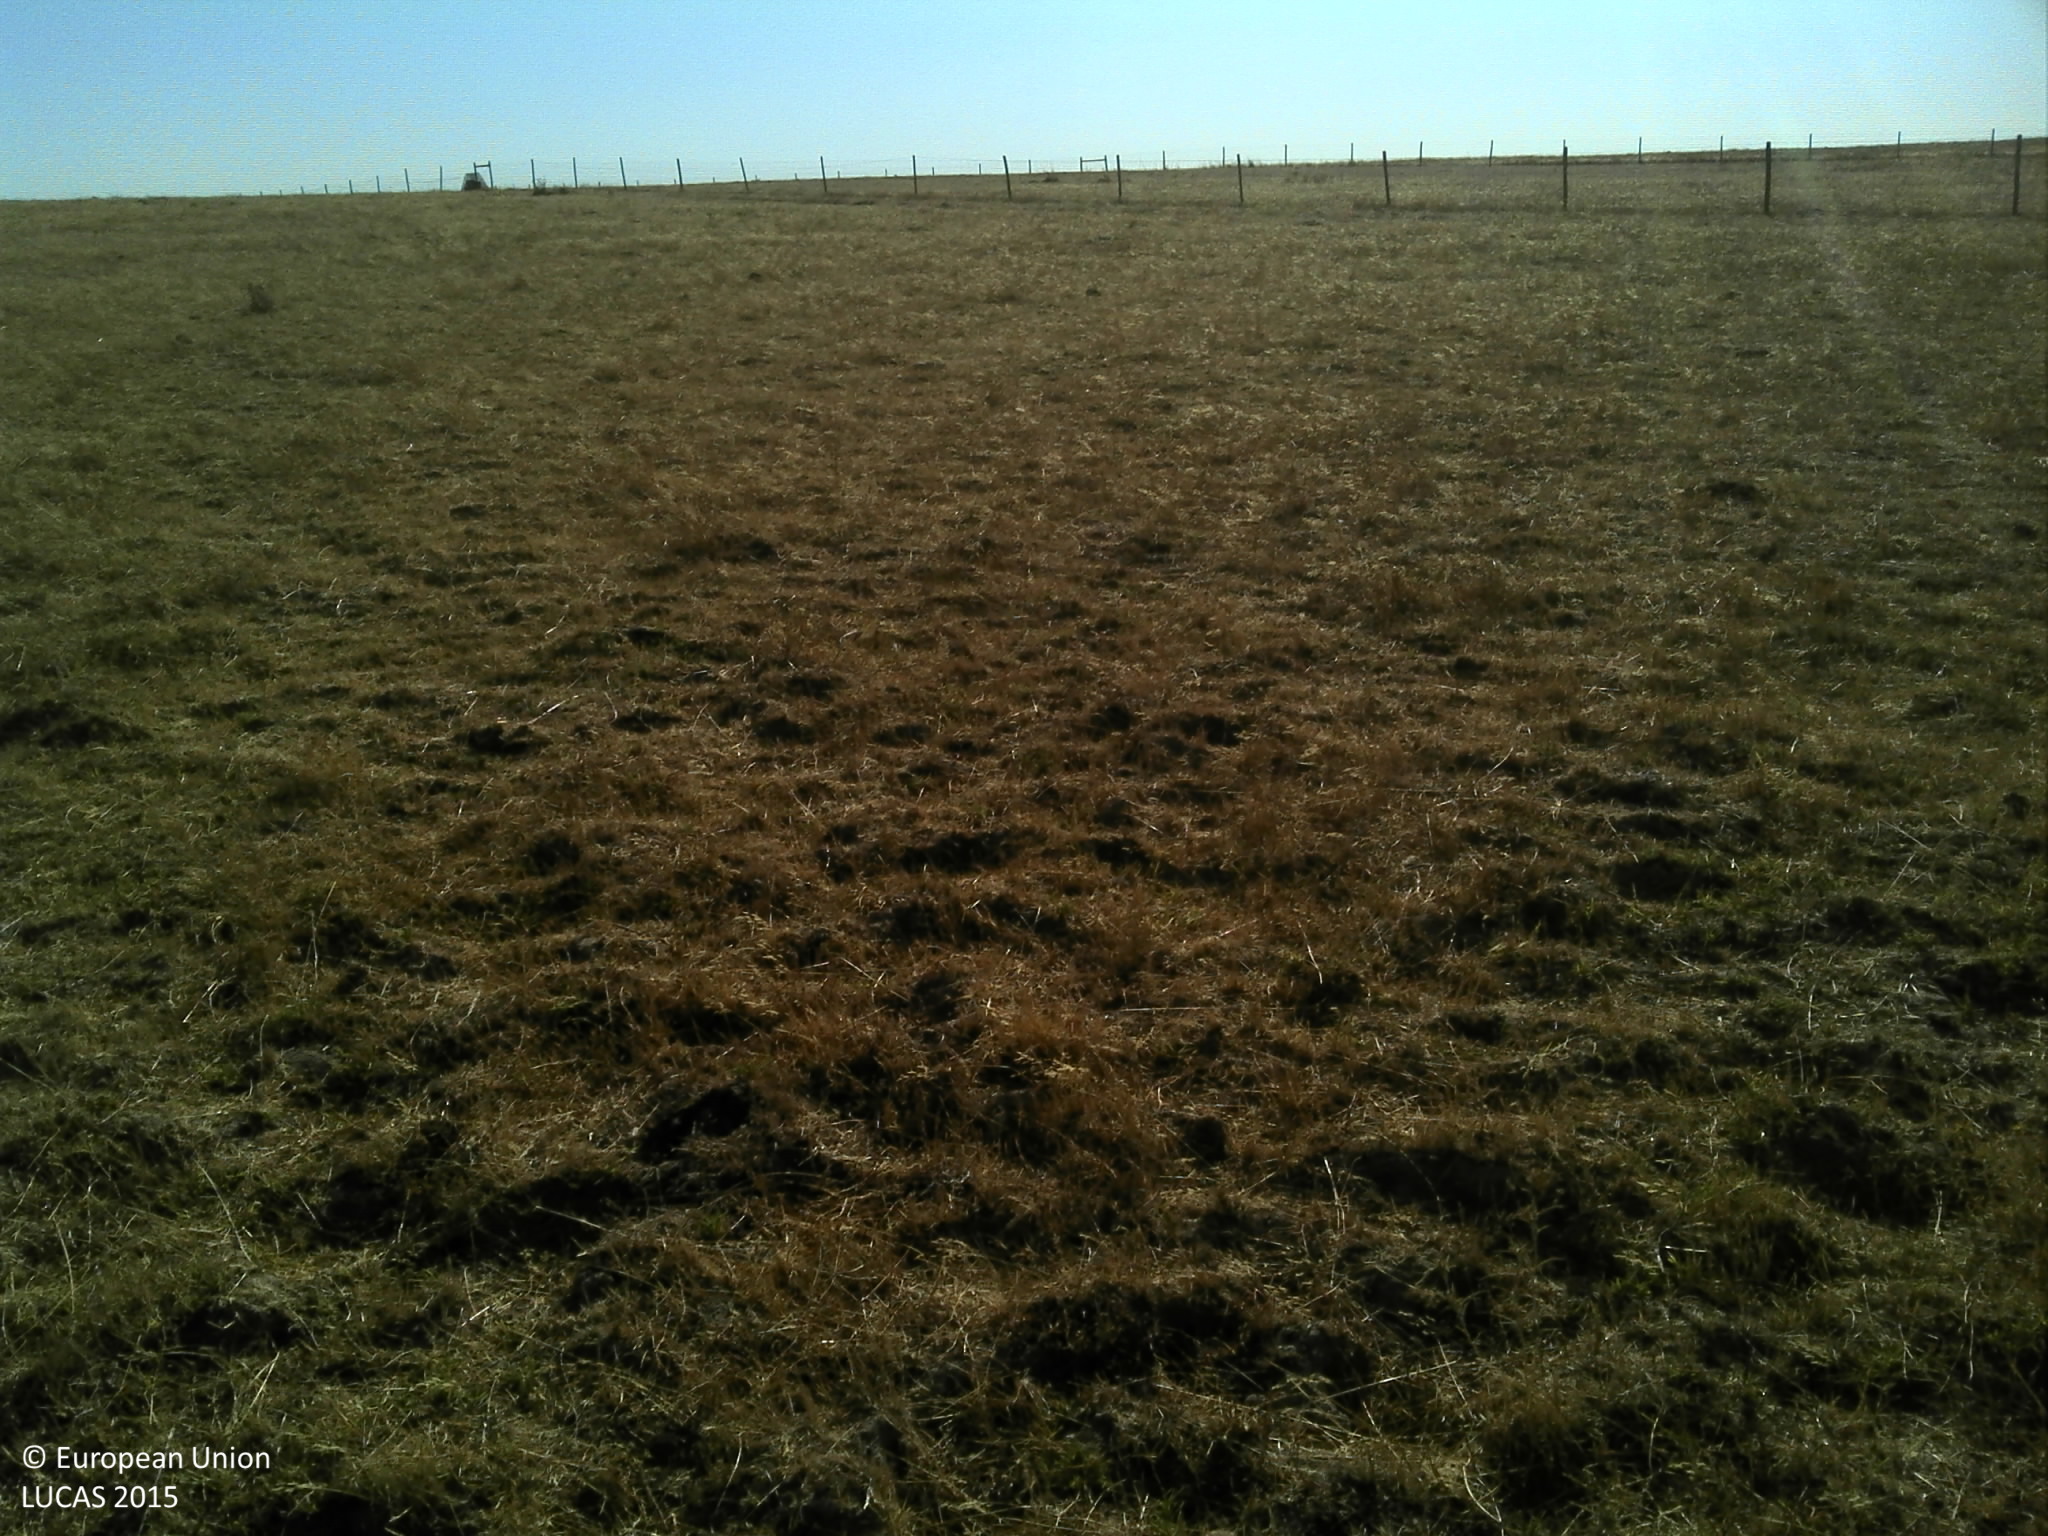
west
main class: Grassland
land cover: Grassland without tree/shrub cover
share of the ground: 10 - 25 %
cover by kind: unconsolidated bare surface 80 %, herbaceous plants 20 %
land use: Agriculture (excluding fallow land and kitchen gardens)
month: July
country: PT
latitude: 38.1065
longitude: -7.9012
